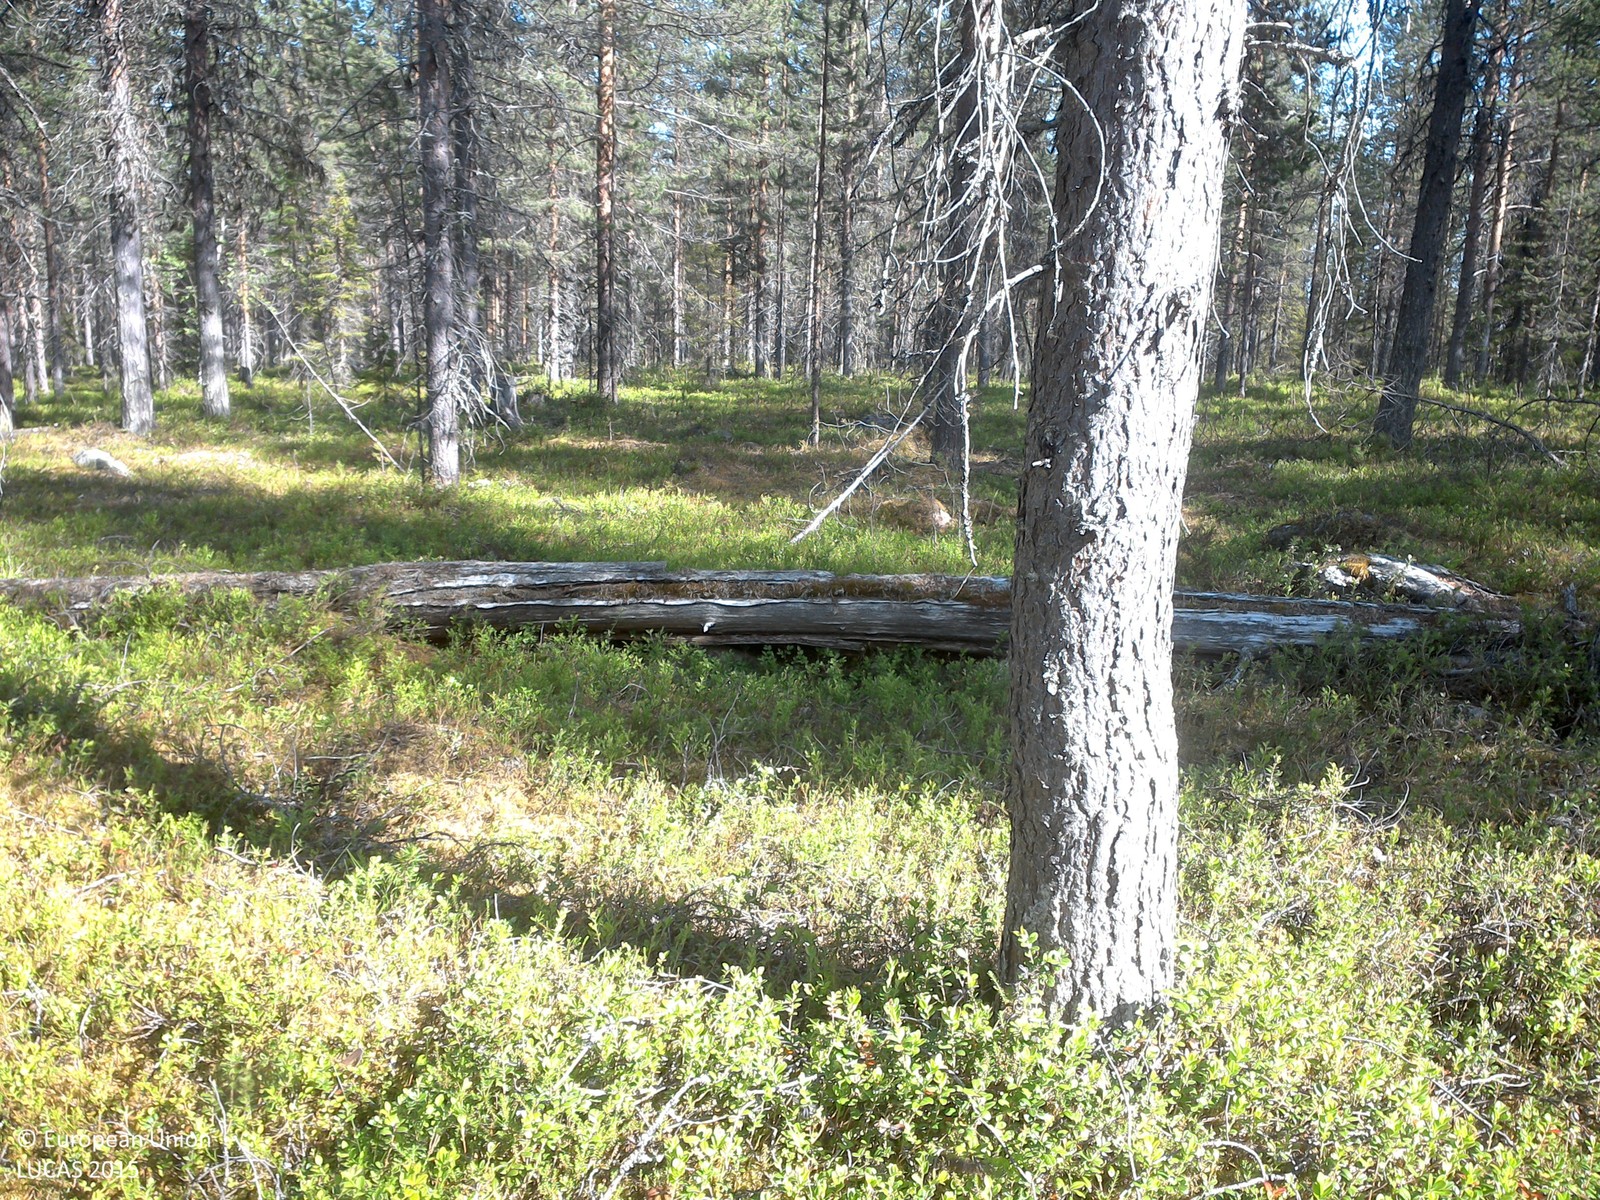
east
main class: Woodland
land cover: Pine dominated coniferous woodland
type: boreal forest
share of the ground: 25 - 50 %
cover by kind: shrubs 60 %, coniferous forest trees 25 %, lichens and mosses 10 %, broadleaved forest trees 5 %
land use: Forestry
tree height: > 5 m
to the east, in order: Pine dominated coniferous woodland
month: July
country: SE
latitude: 67.5483
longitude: 23.3647
